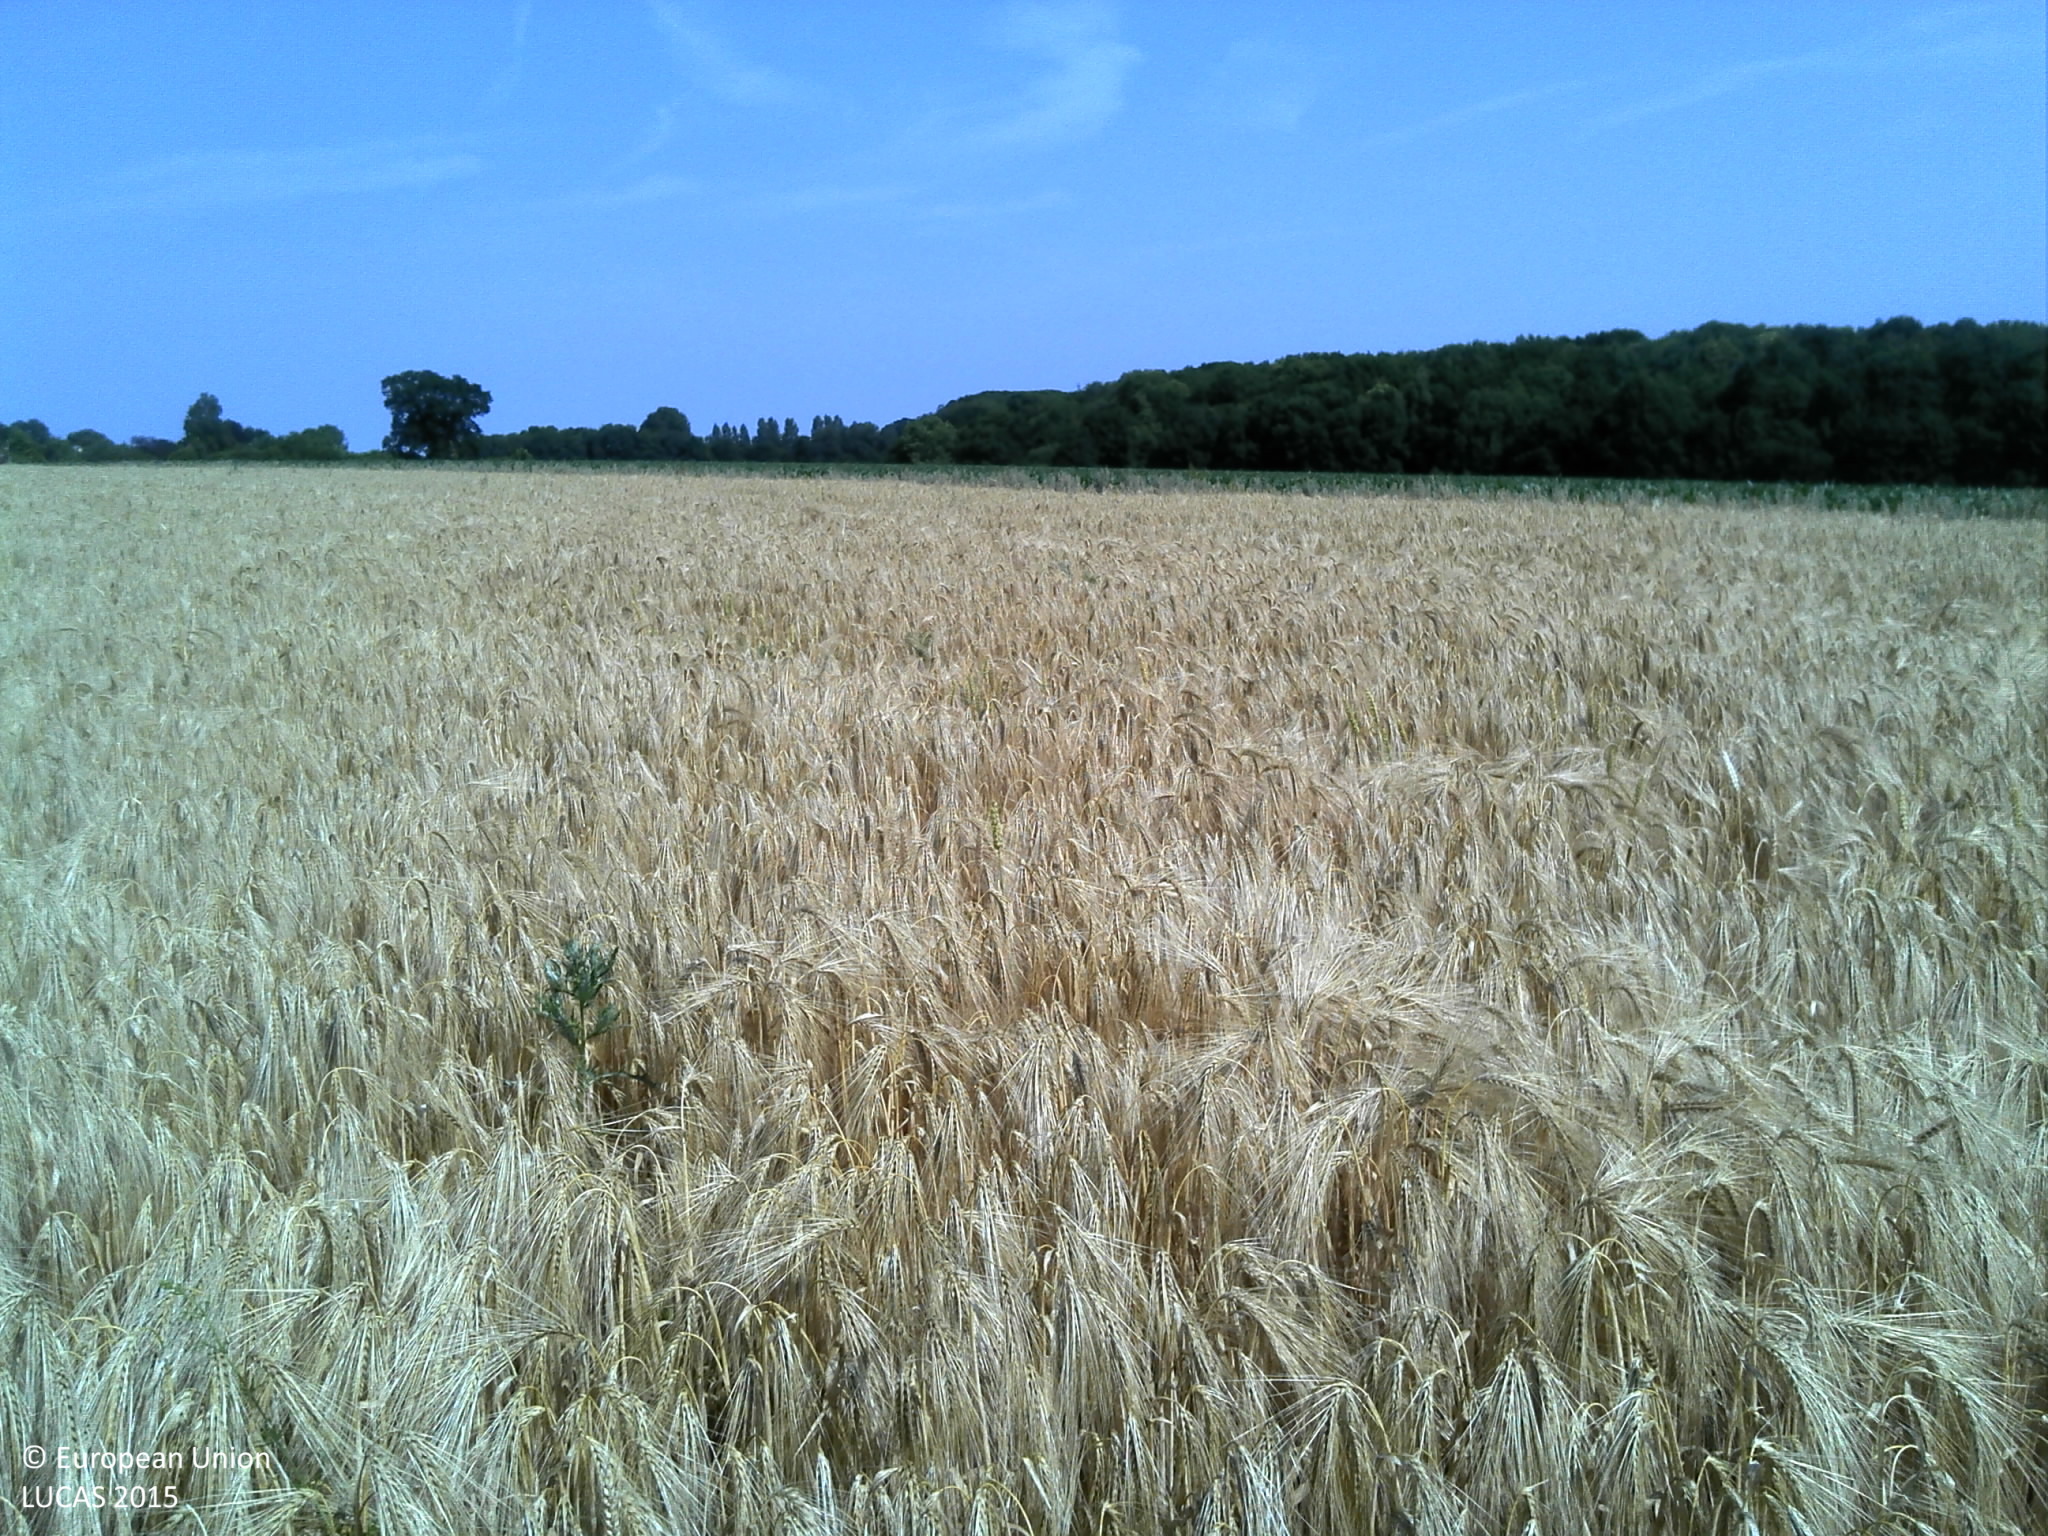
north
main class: Cropland
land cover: Barley
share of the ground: > 75 %
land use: Agriculture (excluding fallow land and kitchen gardens)
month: July
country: FR
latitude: 49.5184
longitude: 1.2080
